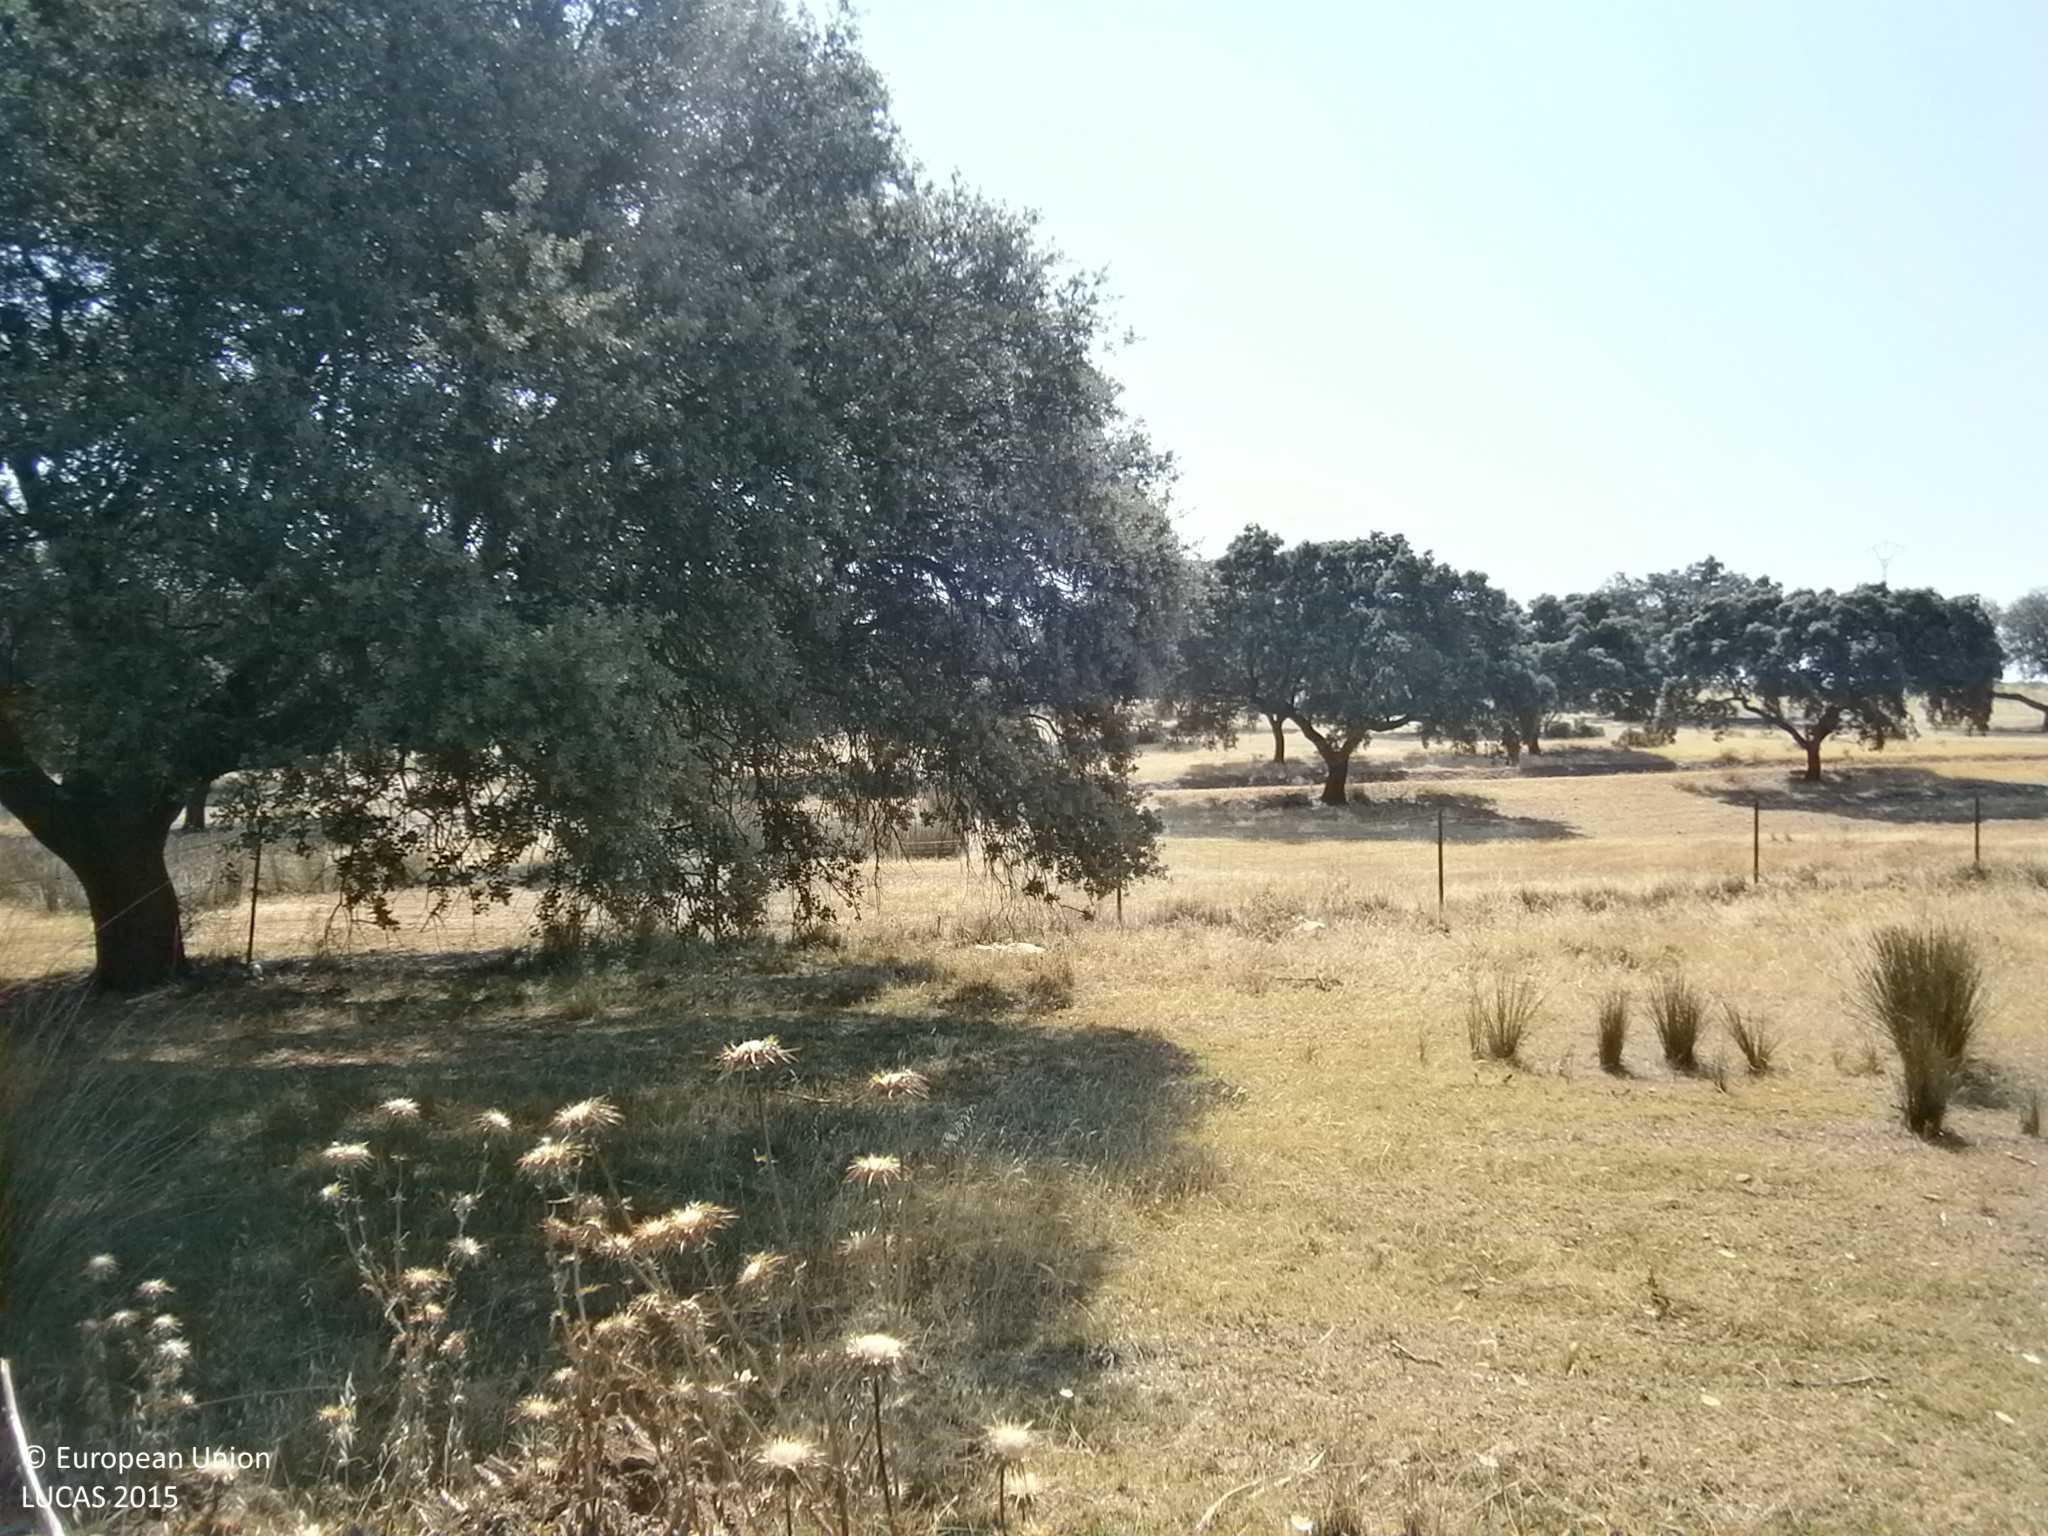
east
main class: Cropland
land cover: Tomatoes
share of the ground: > 75 %
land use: Agriculture (excluding fallow land and kitchen gardens)
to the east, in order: Tomatoes; Ditches and canals; Grassland with sparse tree/shrub cover; Fences; Grassland with sparse tree/shrub cover; Tracks; Grassland without tree/shrub cover; Tracks; Grassland with sparse tree/shrub cover; Fences; Grassland with sparse tree/shrub cover
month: June
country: ES
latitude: 38.8507
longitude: -6.7610
